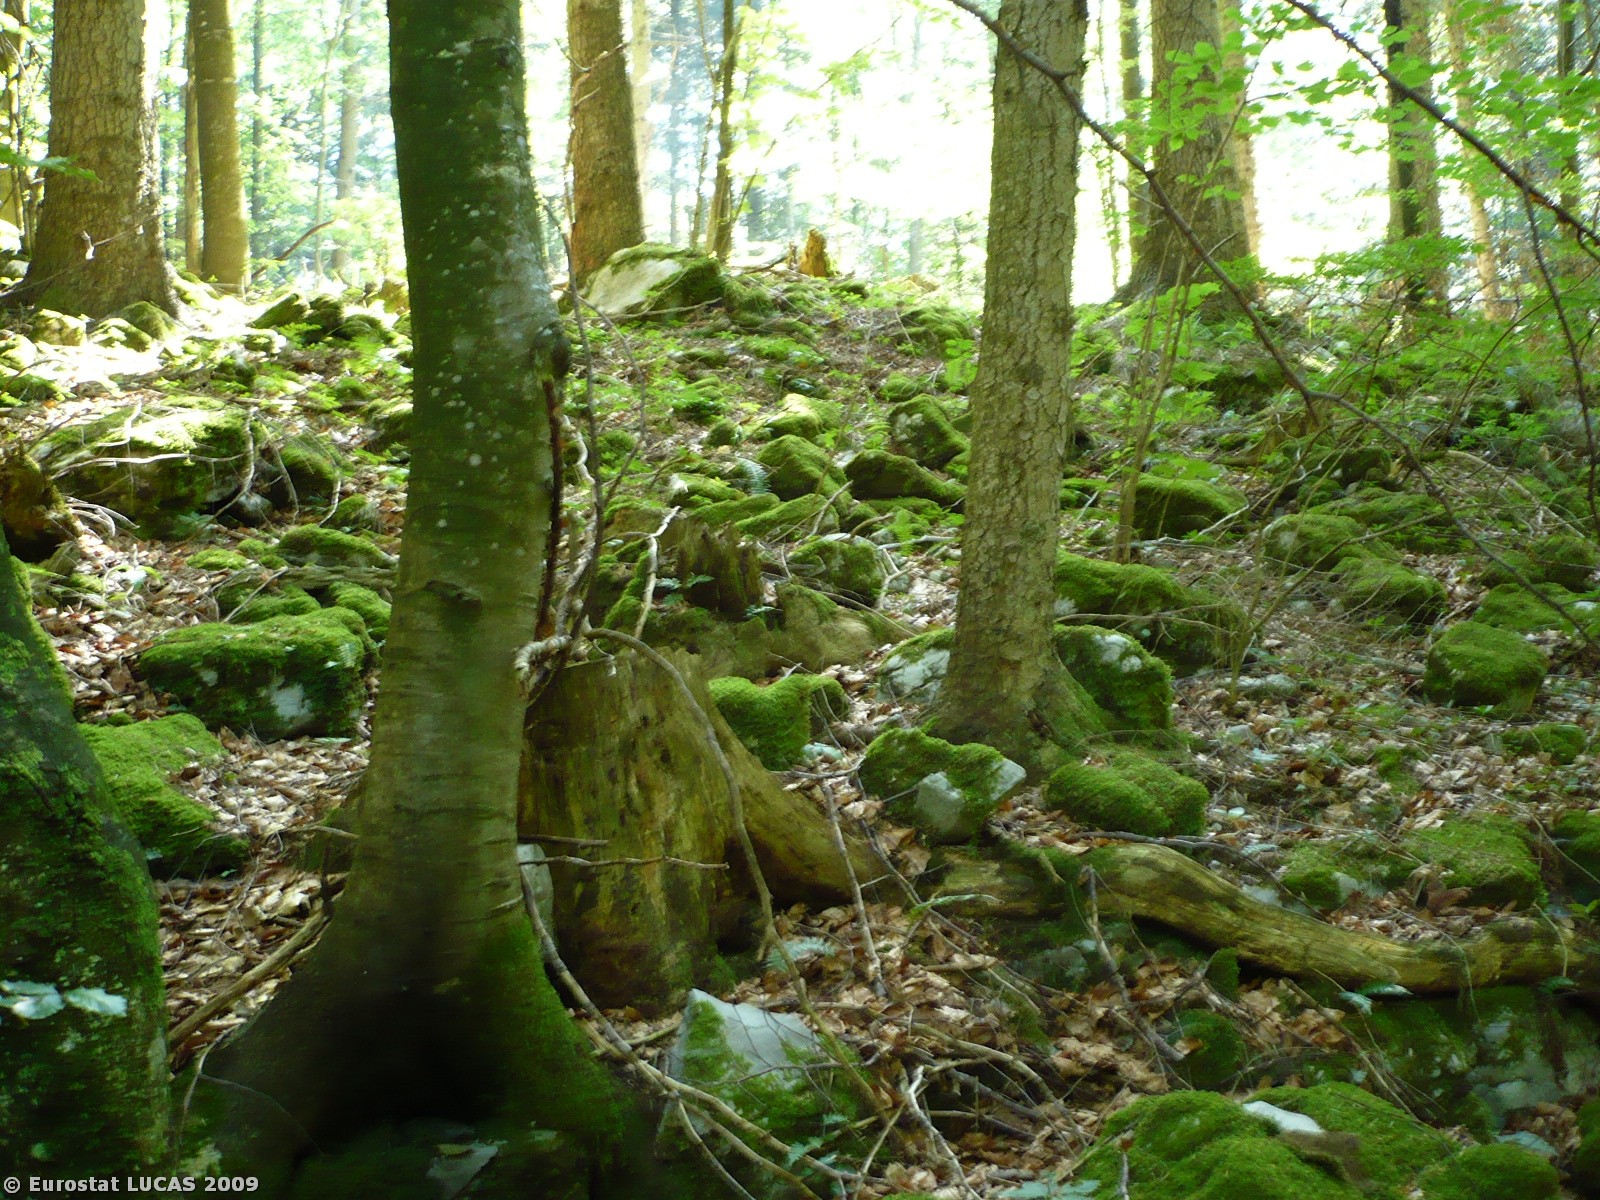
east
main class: Woodland
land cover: Mixed woodland
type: mountainous beech forest
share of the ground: > 75 %
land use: Forestry
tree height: > 5 m
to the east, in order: Mixed woodland; Spontaneously vegetated surfaces; Mixed woodland; Tracks; Mixed woodland; Tracks; Mixed woodland; Tracks; Mixed woodland; Tracks; Mixed woodland
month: July
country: SI
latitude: 45.7225
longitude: 14.3257
